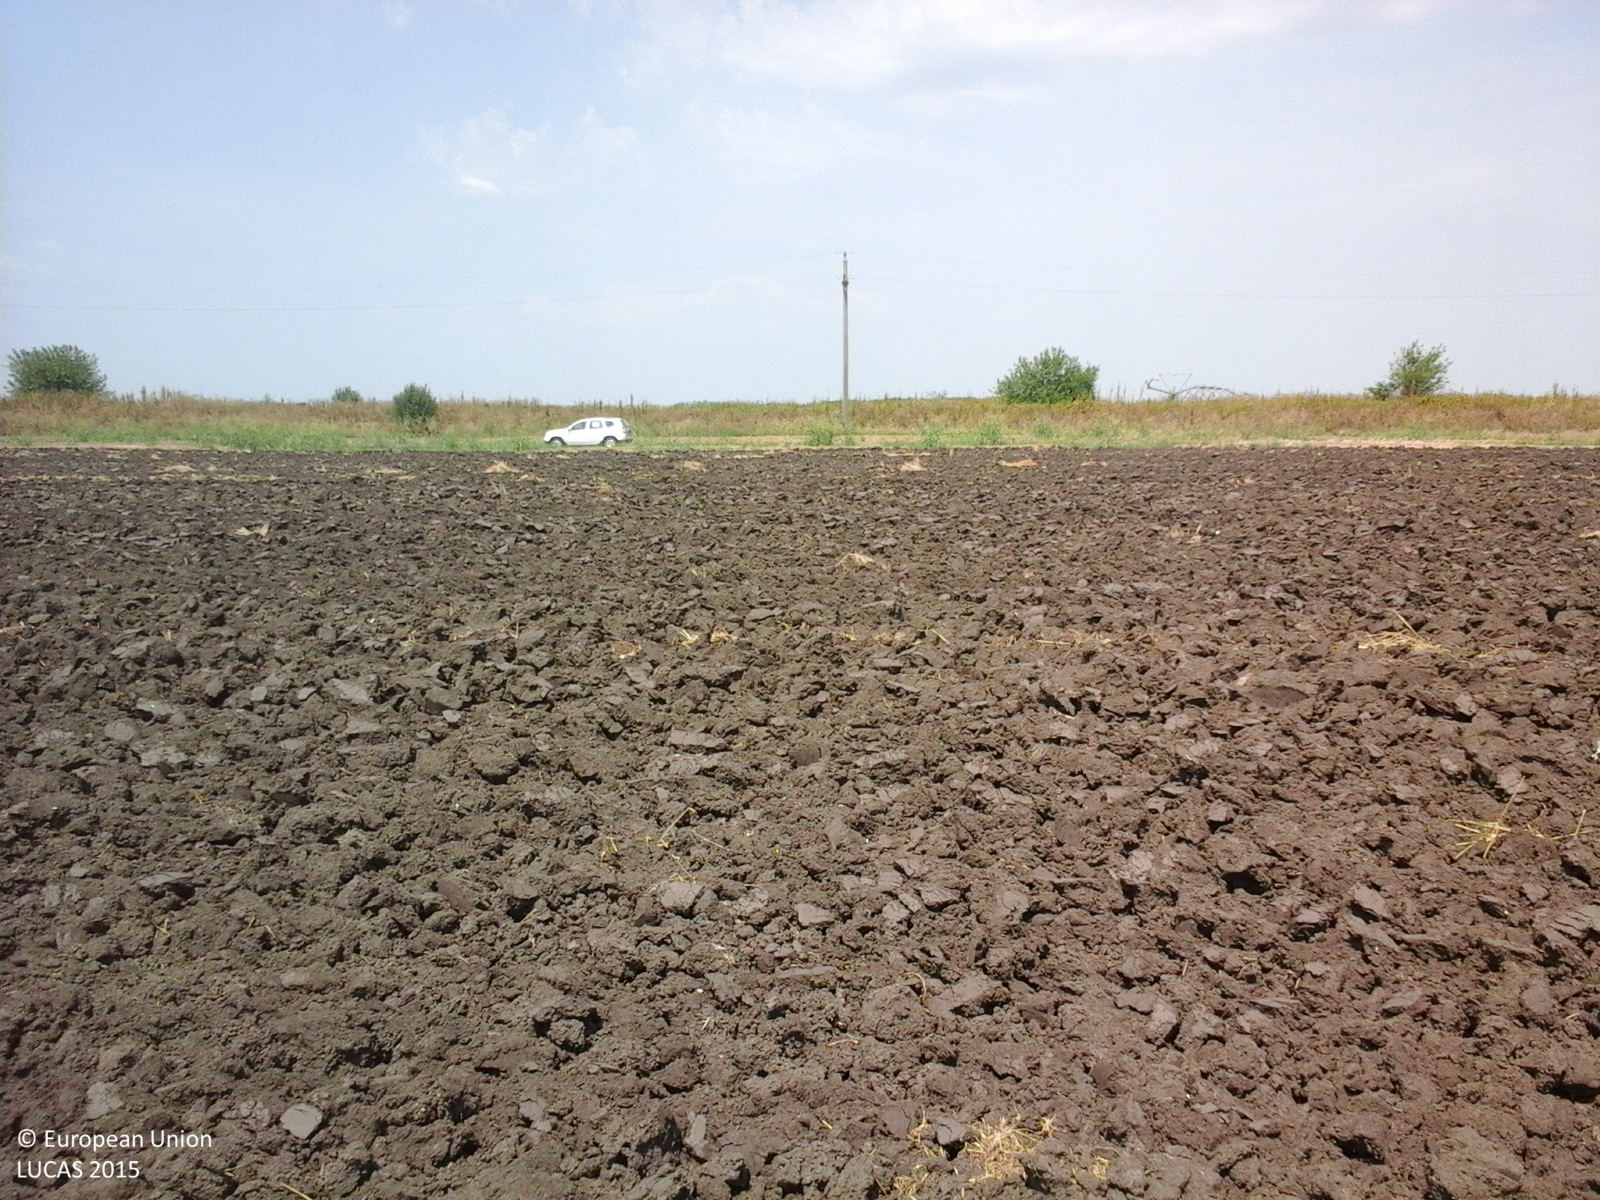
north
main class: Cropland
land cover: Barley
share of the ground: < 10 %
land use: Agriculture (excluding fallow land and kitchen gardens)
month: August
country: RO
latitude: 43.9459
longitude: 23.7203
